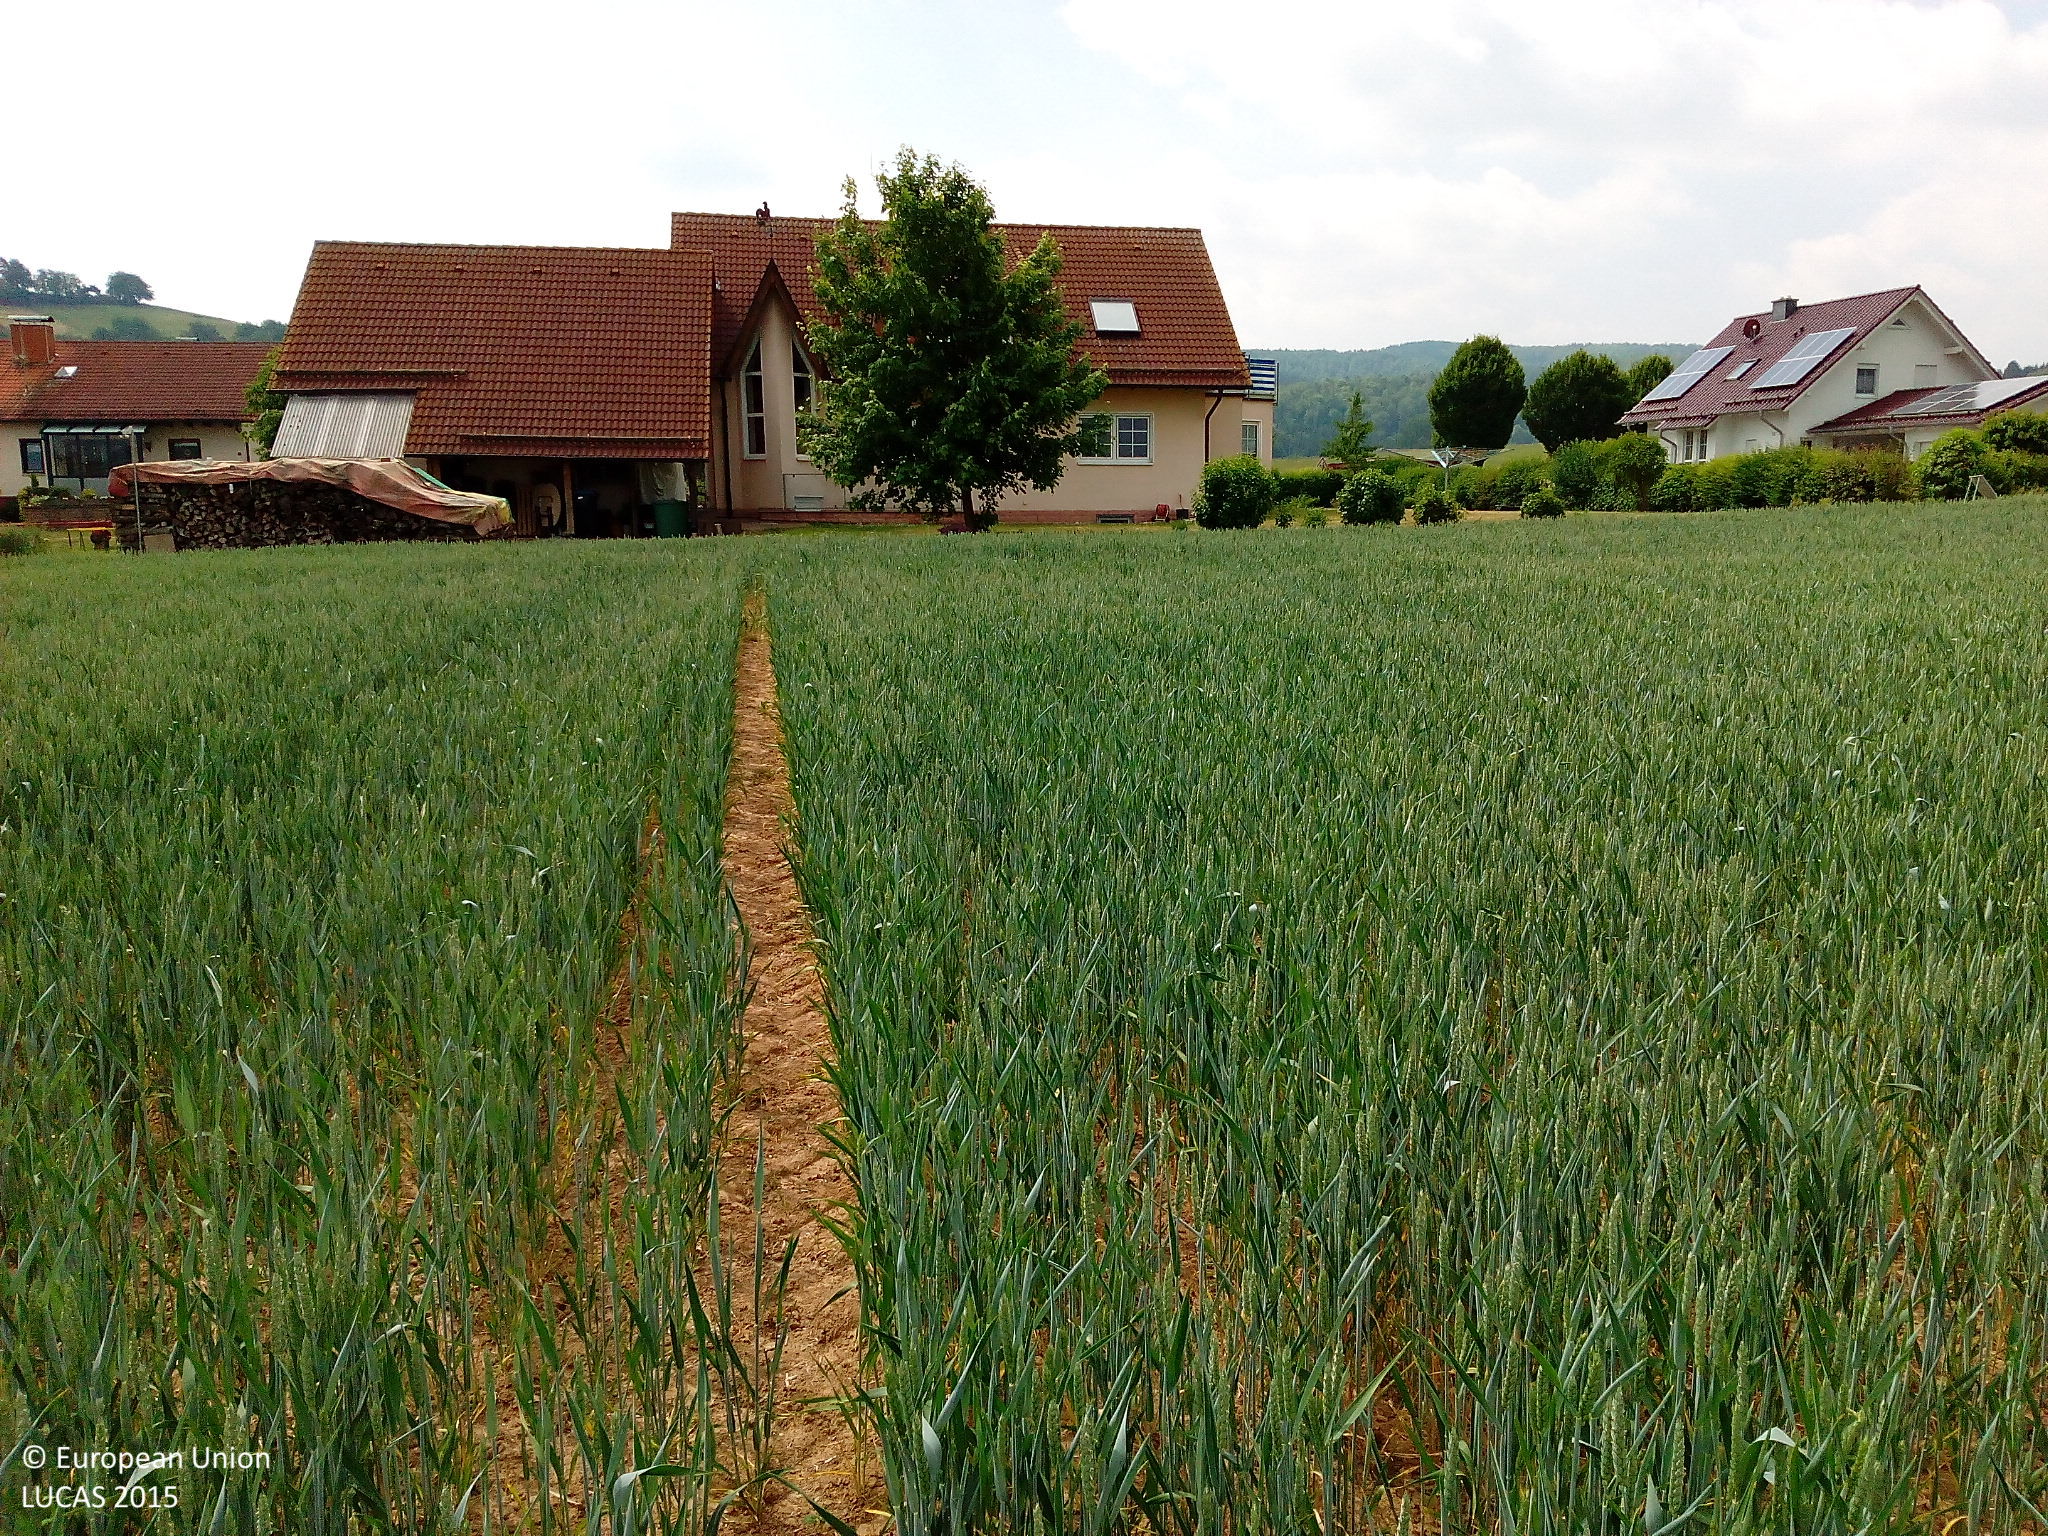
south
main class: Cropland
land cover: Common wheat
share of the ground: > 75 %
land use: Agriculture (excluding fallow land and kitchen gardens)
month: June
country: DE
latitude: 51.0108
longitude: 9.6438
